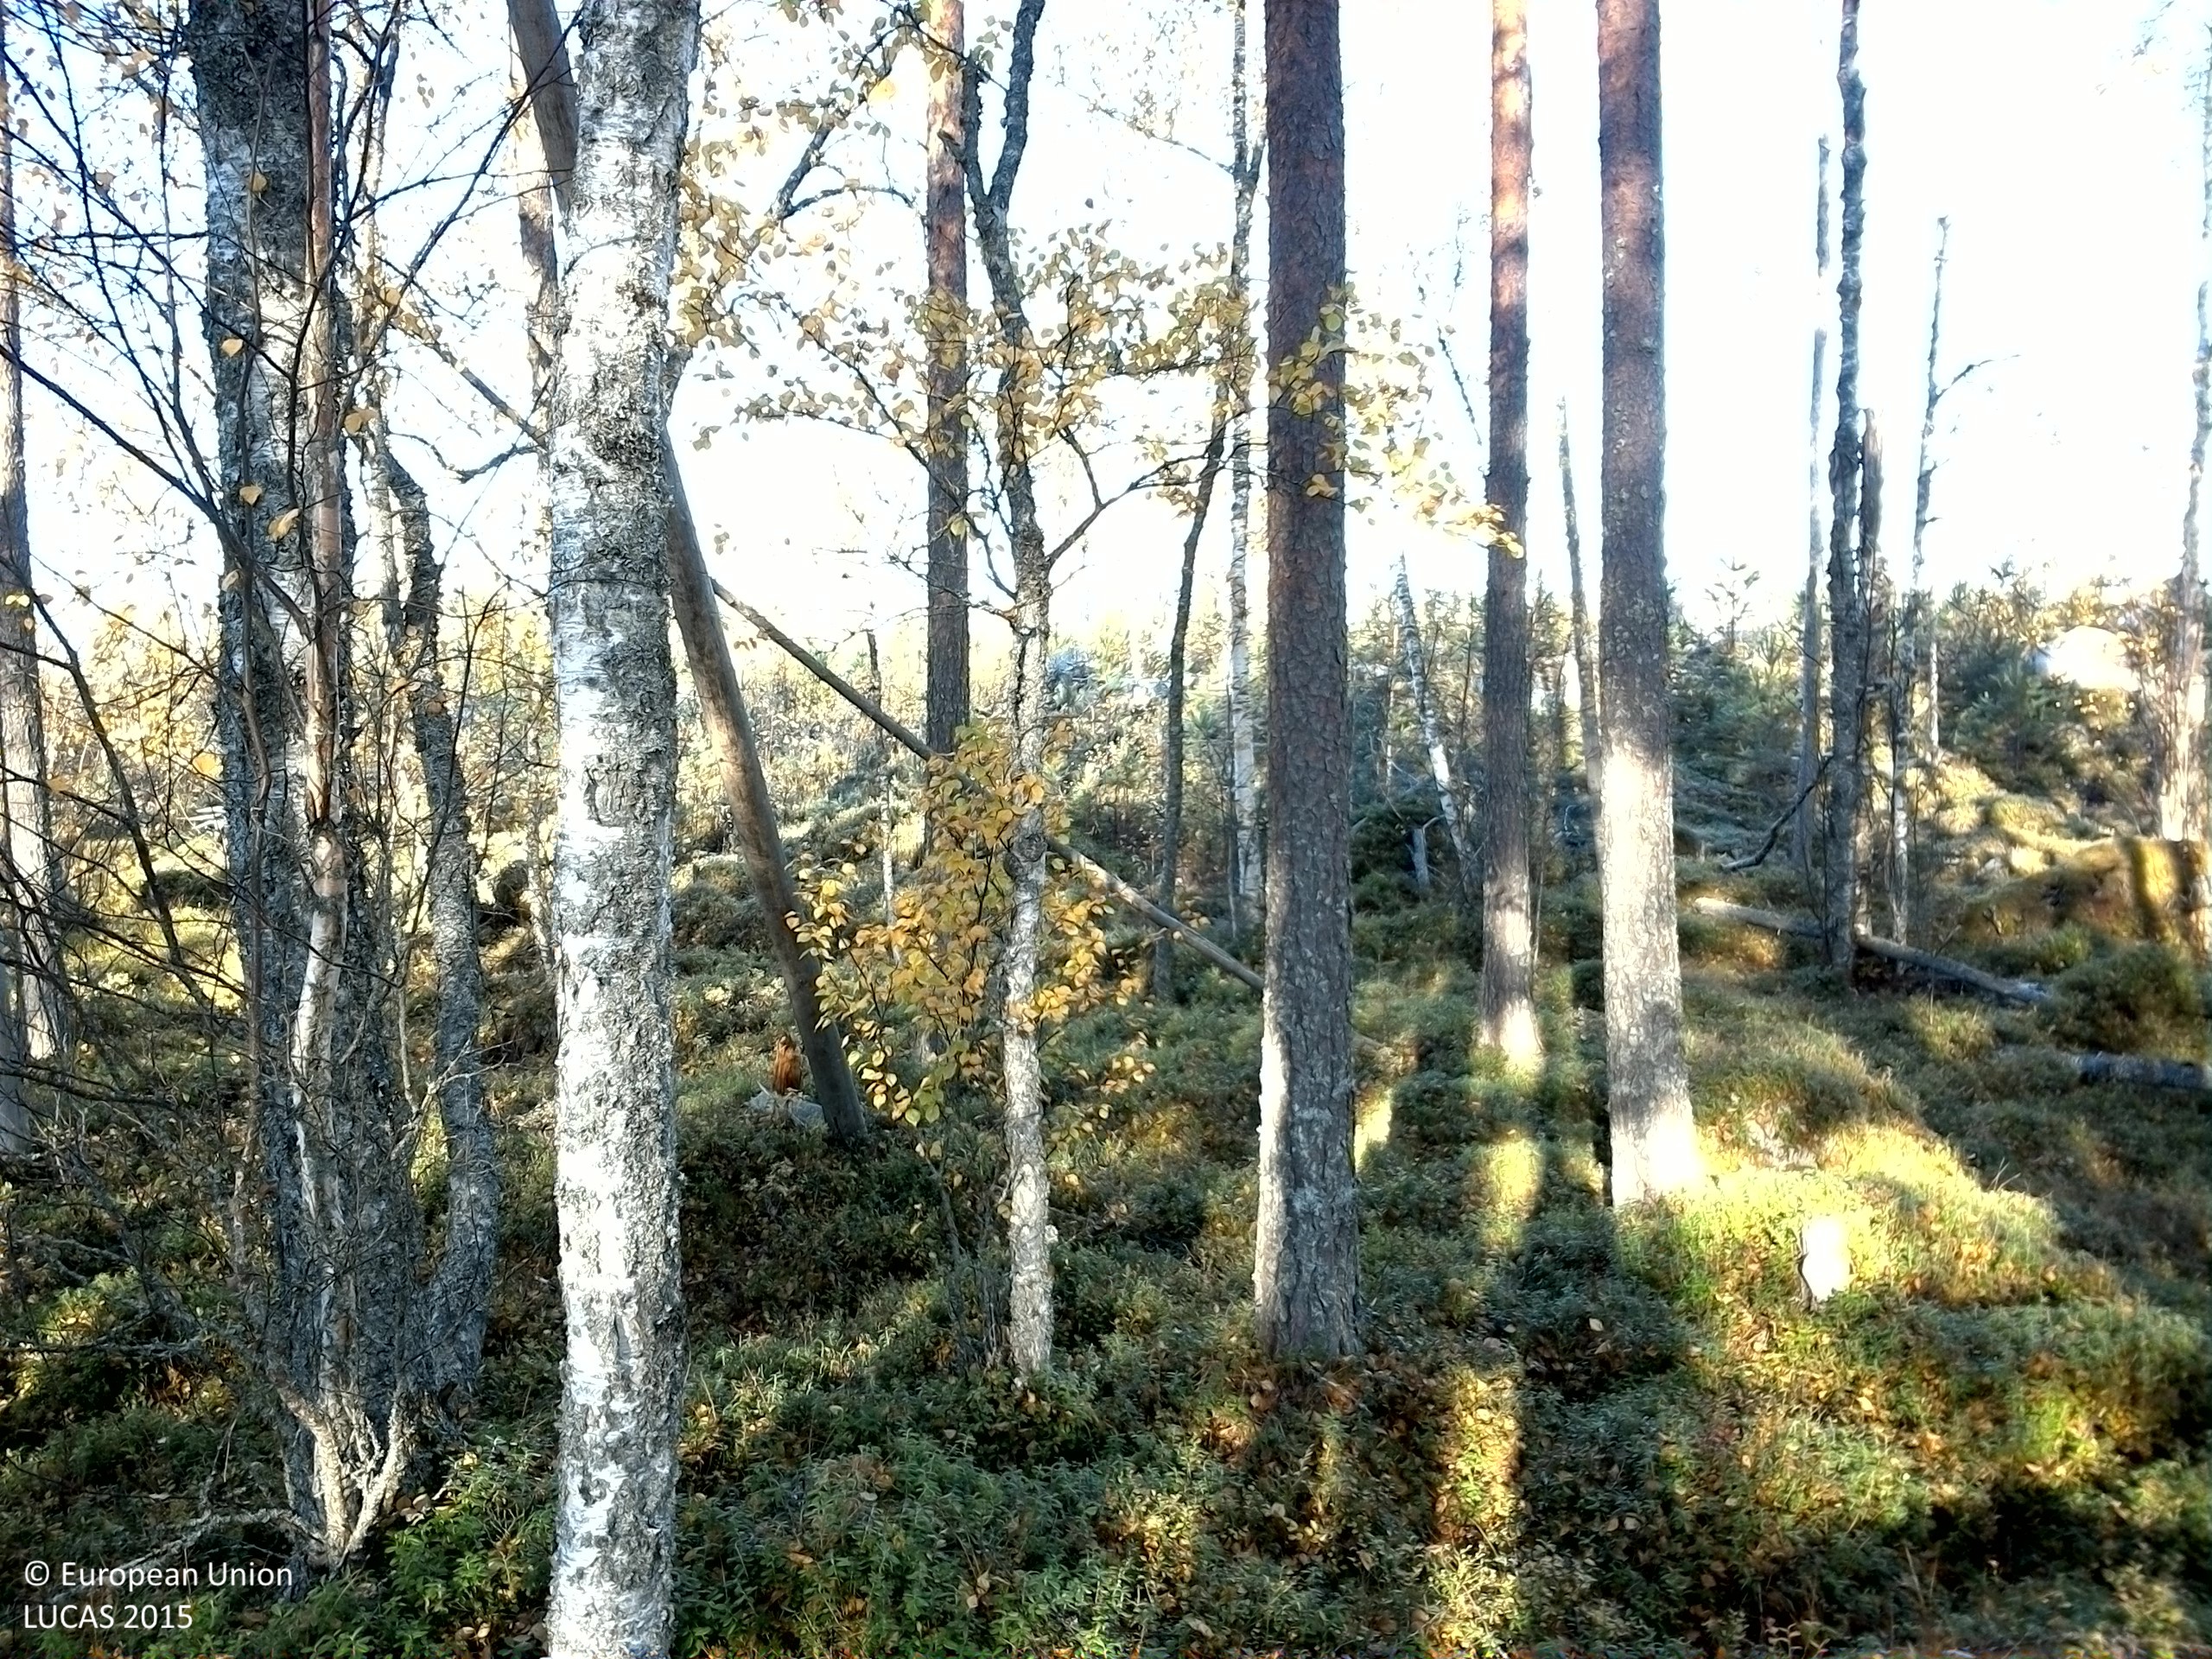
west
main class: Woodland
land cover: Pine dominated mixed woodland
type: boreal forest
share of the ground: 50 - 75 %
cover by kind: coniferous forest trees 35 %, shrubs 25 %, broadleaved forest trees 20 %, lichens and mosses 10 %, consolidated bare surface 10 %
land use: Forestry
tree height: > 5 m
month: October
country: SE
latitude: 61.3702
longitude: 15.0923
